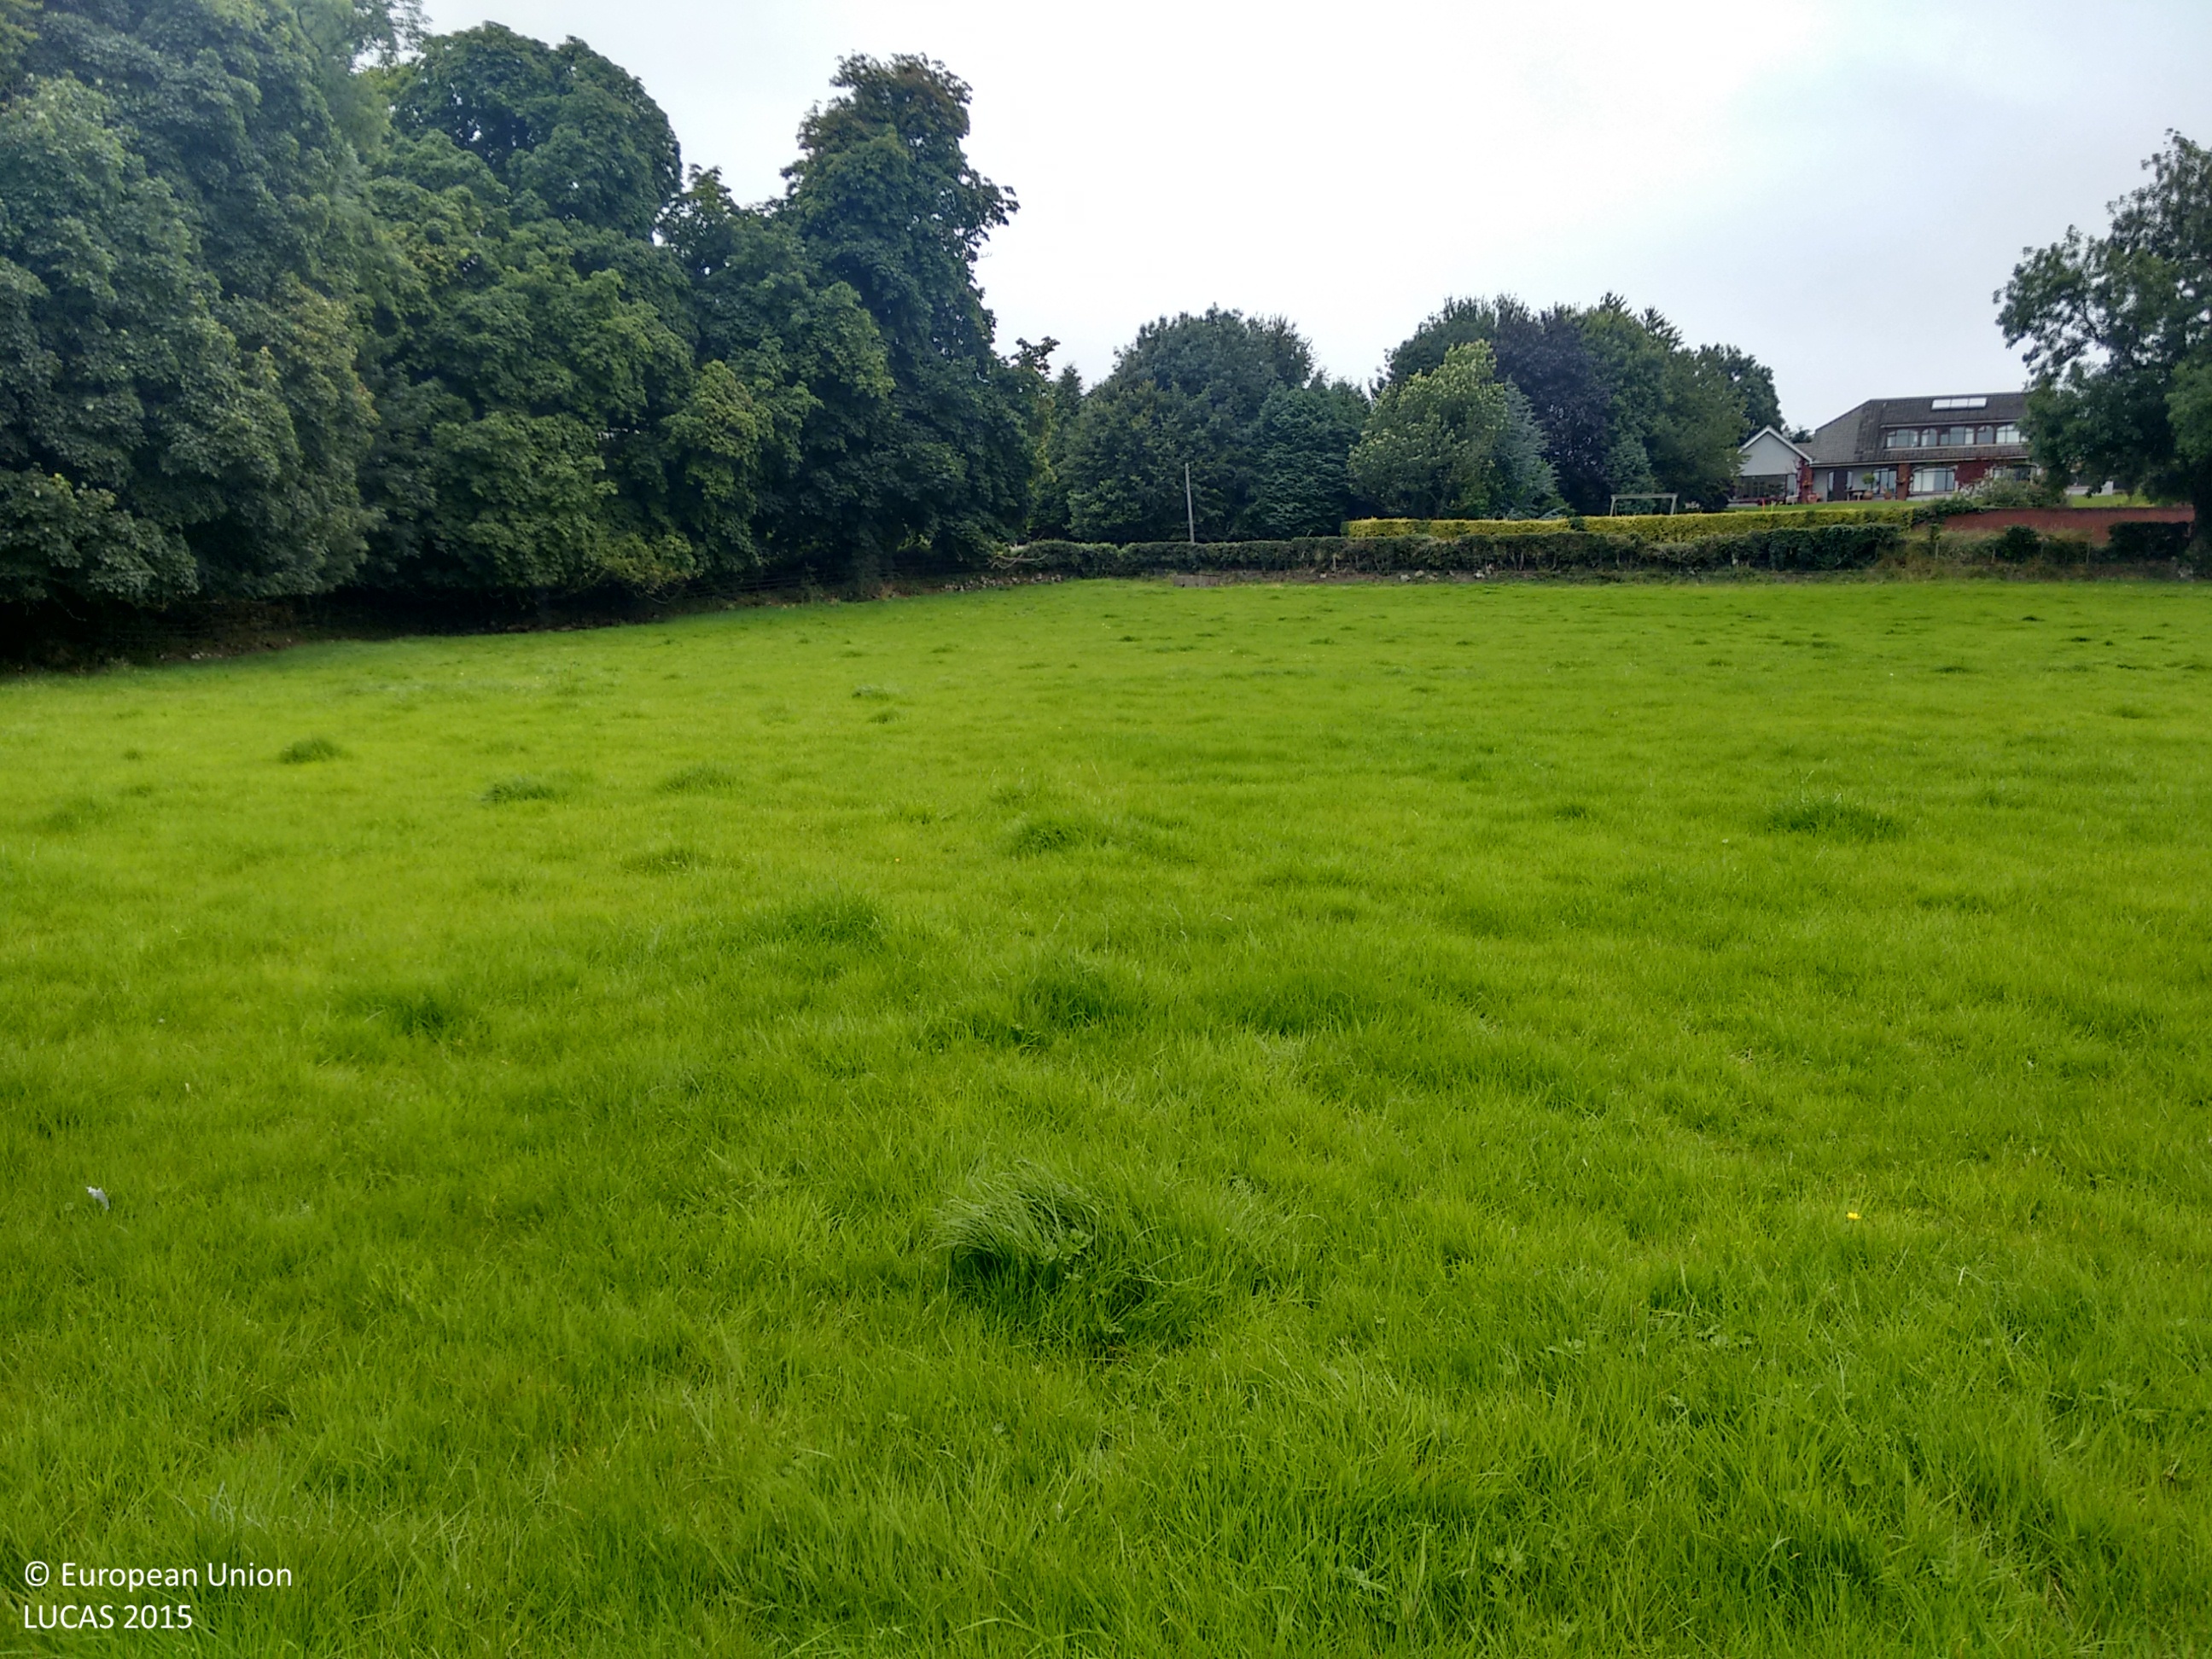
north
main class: Grassland
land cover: Grassland without tree/shrub cover
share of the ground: > 75 %
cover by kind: herbaceous plants 100 %
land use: Agriculture (excluding fallow land and kitchen gardens)
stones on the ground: < 10 %
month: August
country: IE
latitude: 53.9723
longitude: -6.7351
